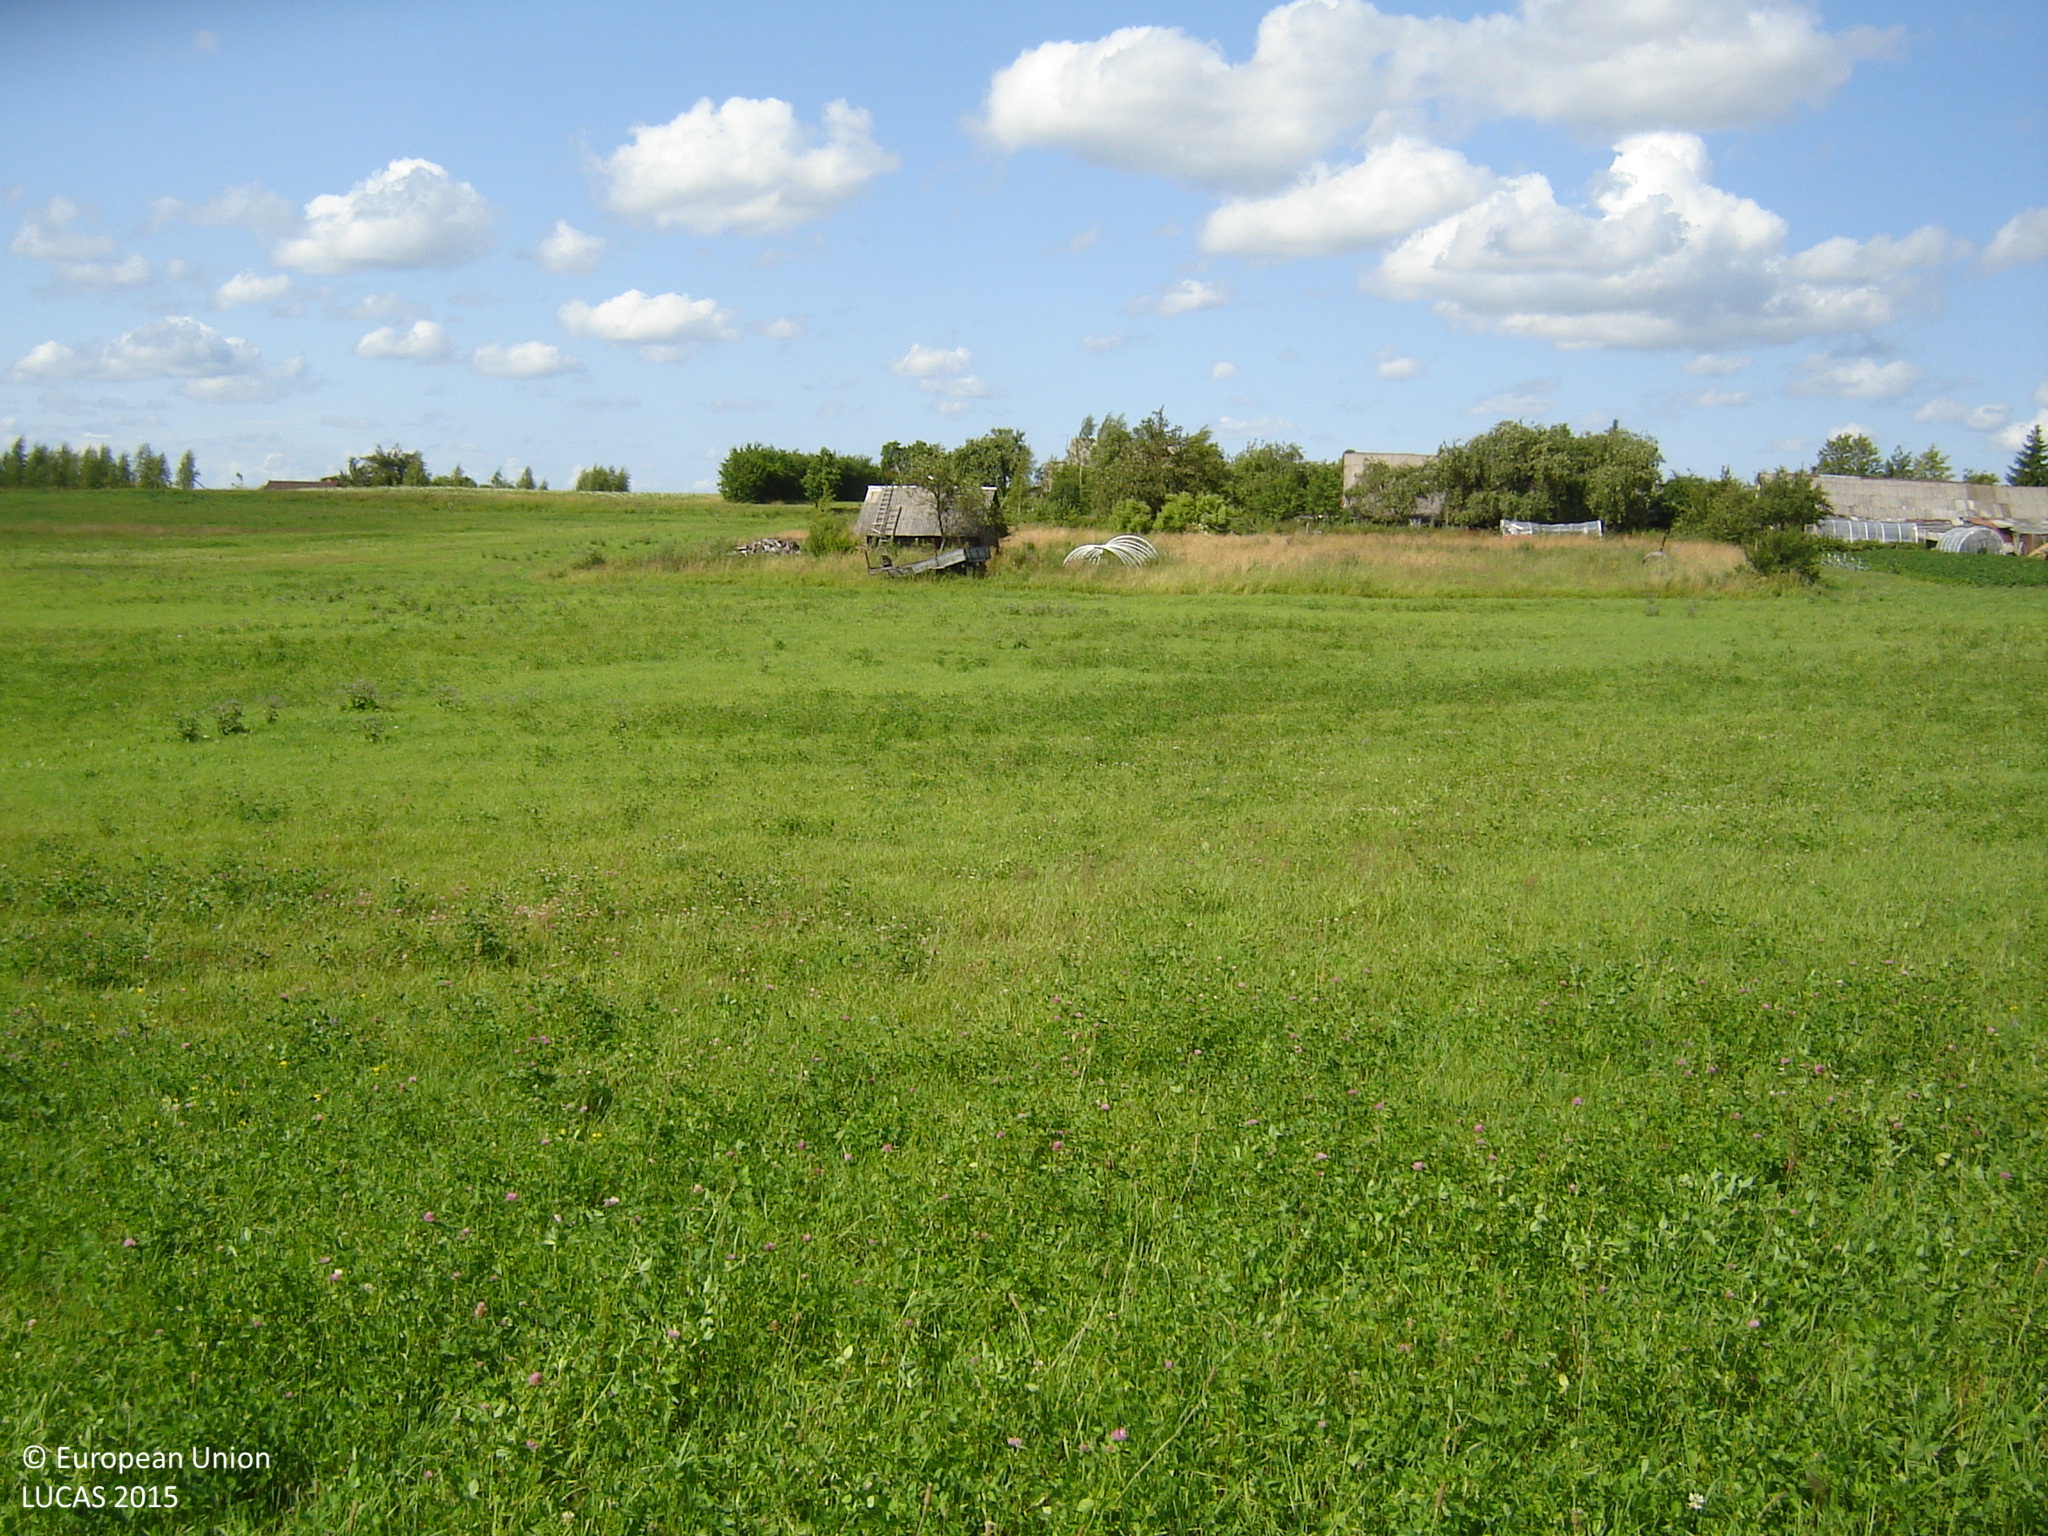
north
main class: Grassland
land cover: Grassland without tree/shrub cover
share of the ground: > 75 %
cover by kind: herbaceous plants 100 %
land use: Agriculture (excluding fallow land and kitchen gardens)
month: July
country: LT
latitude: 55.4905
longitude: 25.2323
